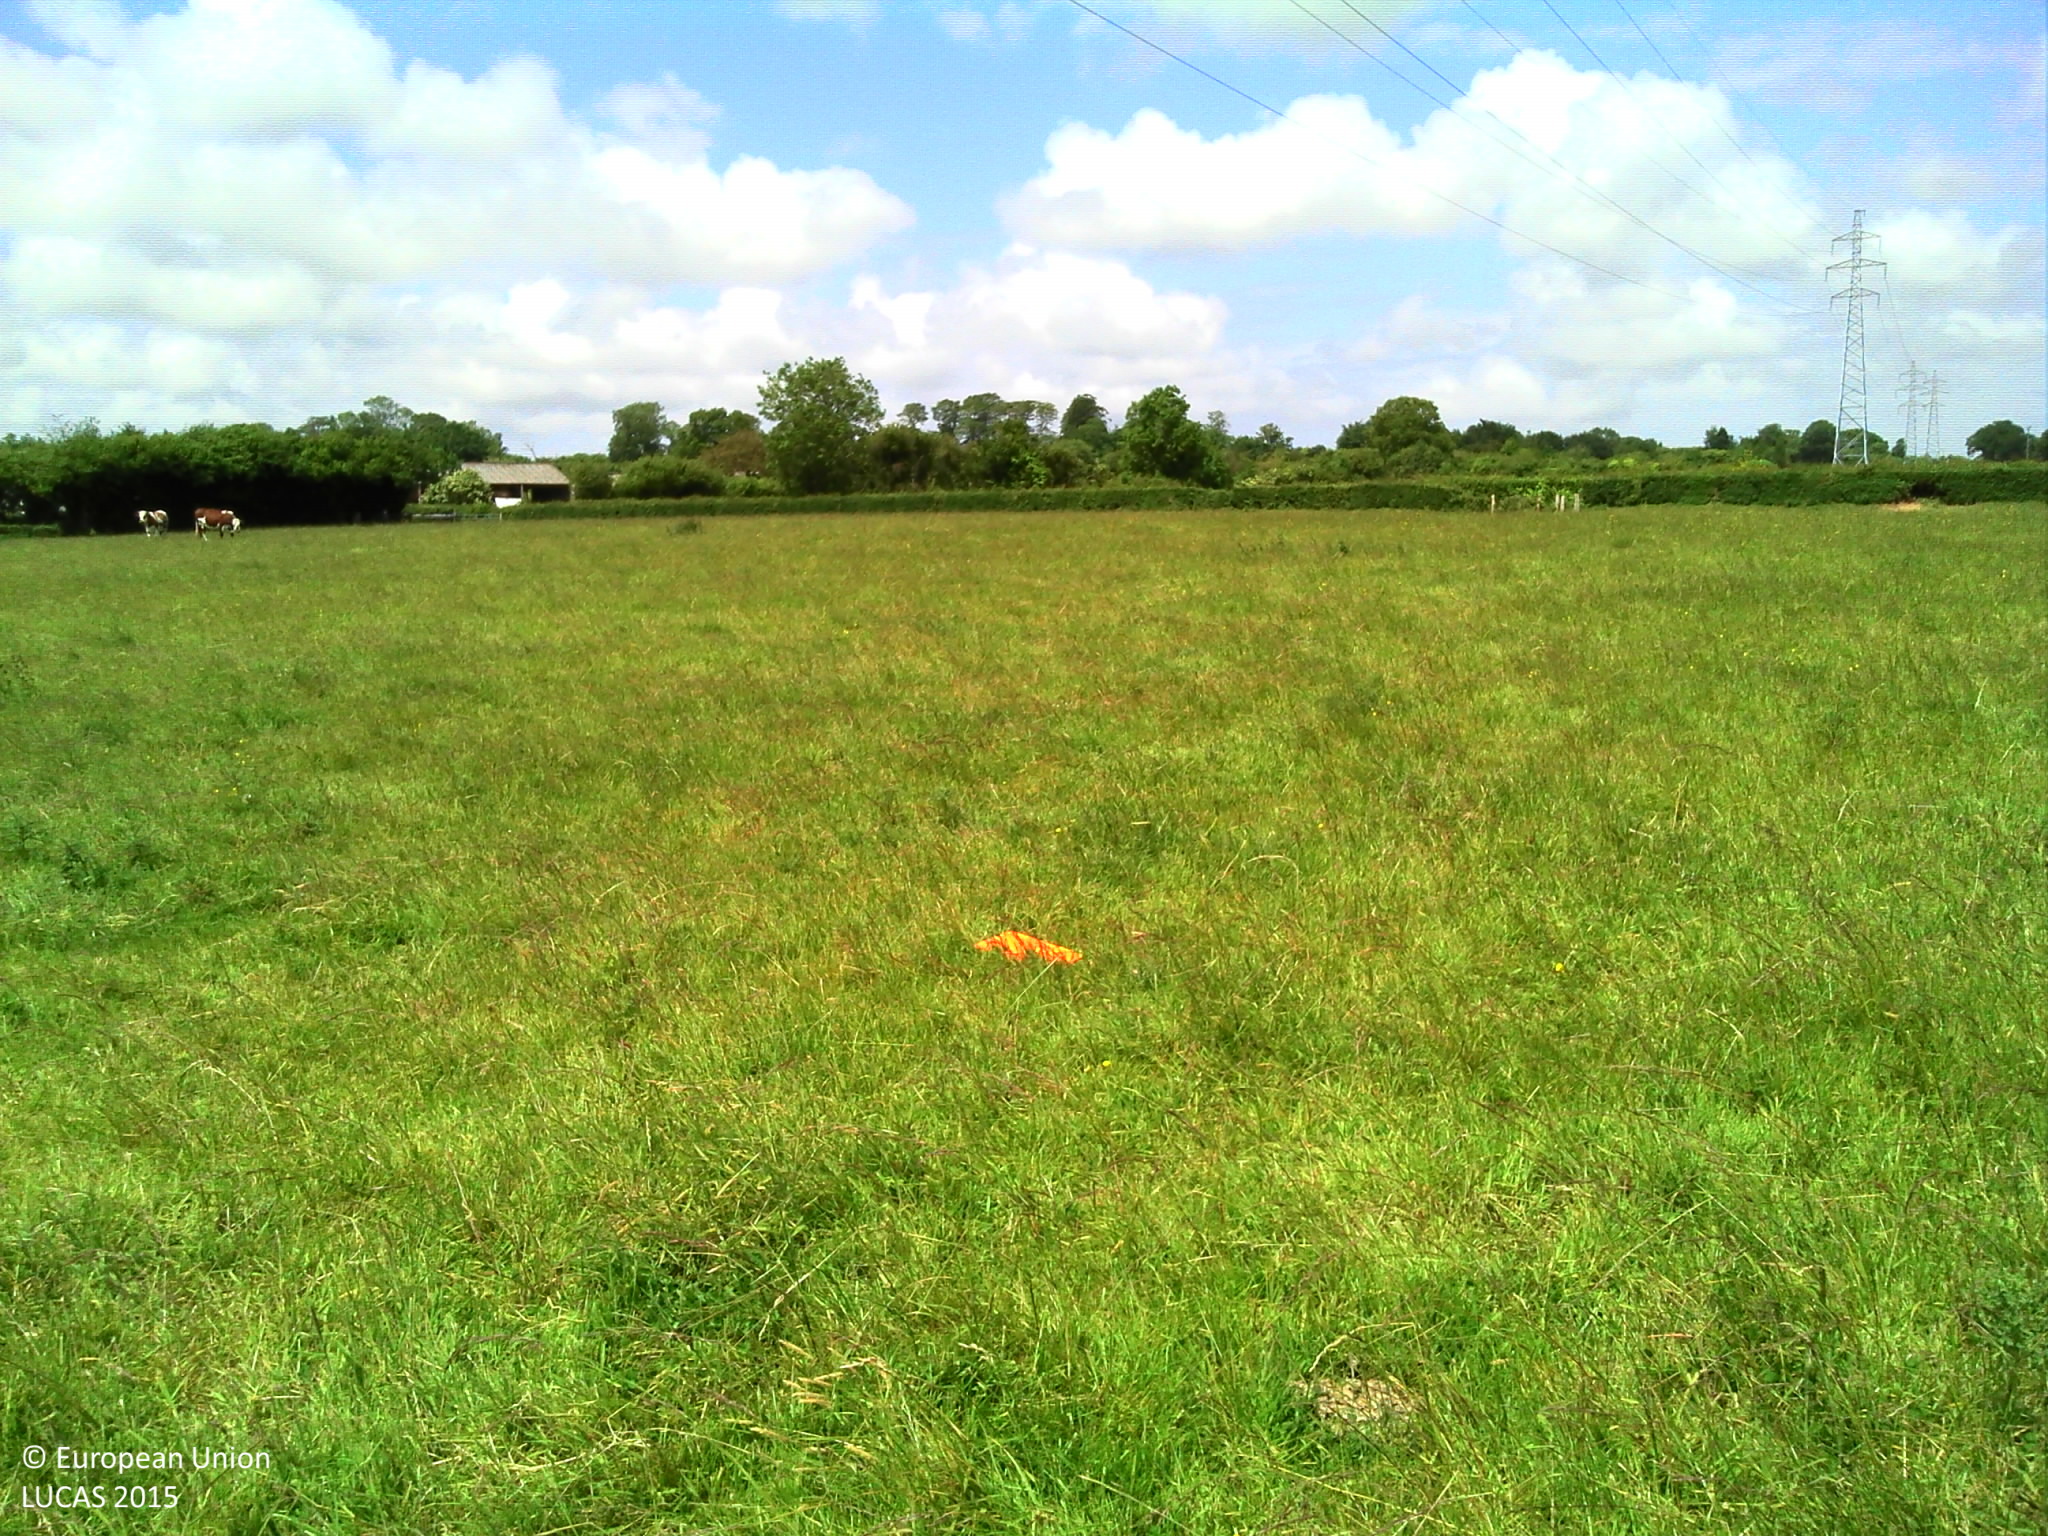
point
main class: Grassland
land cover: Grassland without tree/shrub cover
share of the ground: > 75 %
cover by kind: herbaceous plants 100 %
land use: Agriculture (excluding fallow land and kitchen gardens)
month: June
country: FR
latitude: 49.5710
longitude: -1.4291
